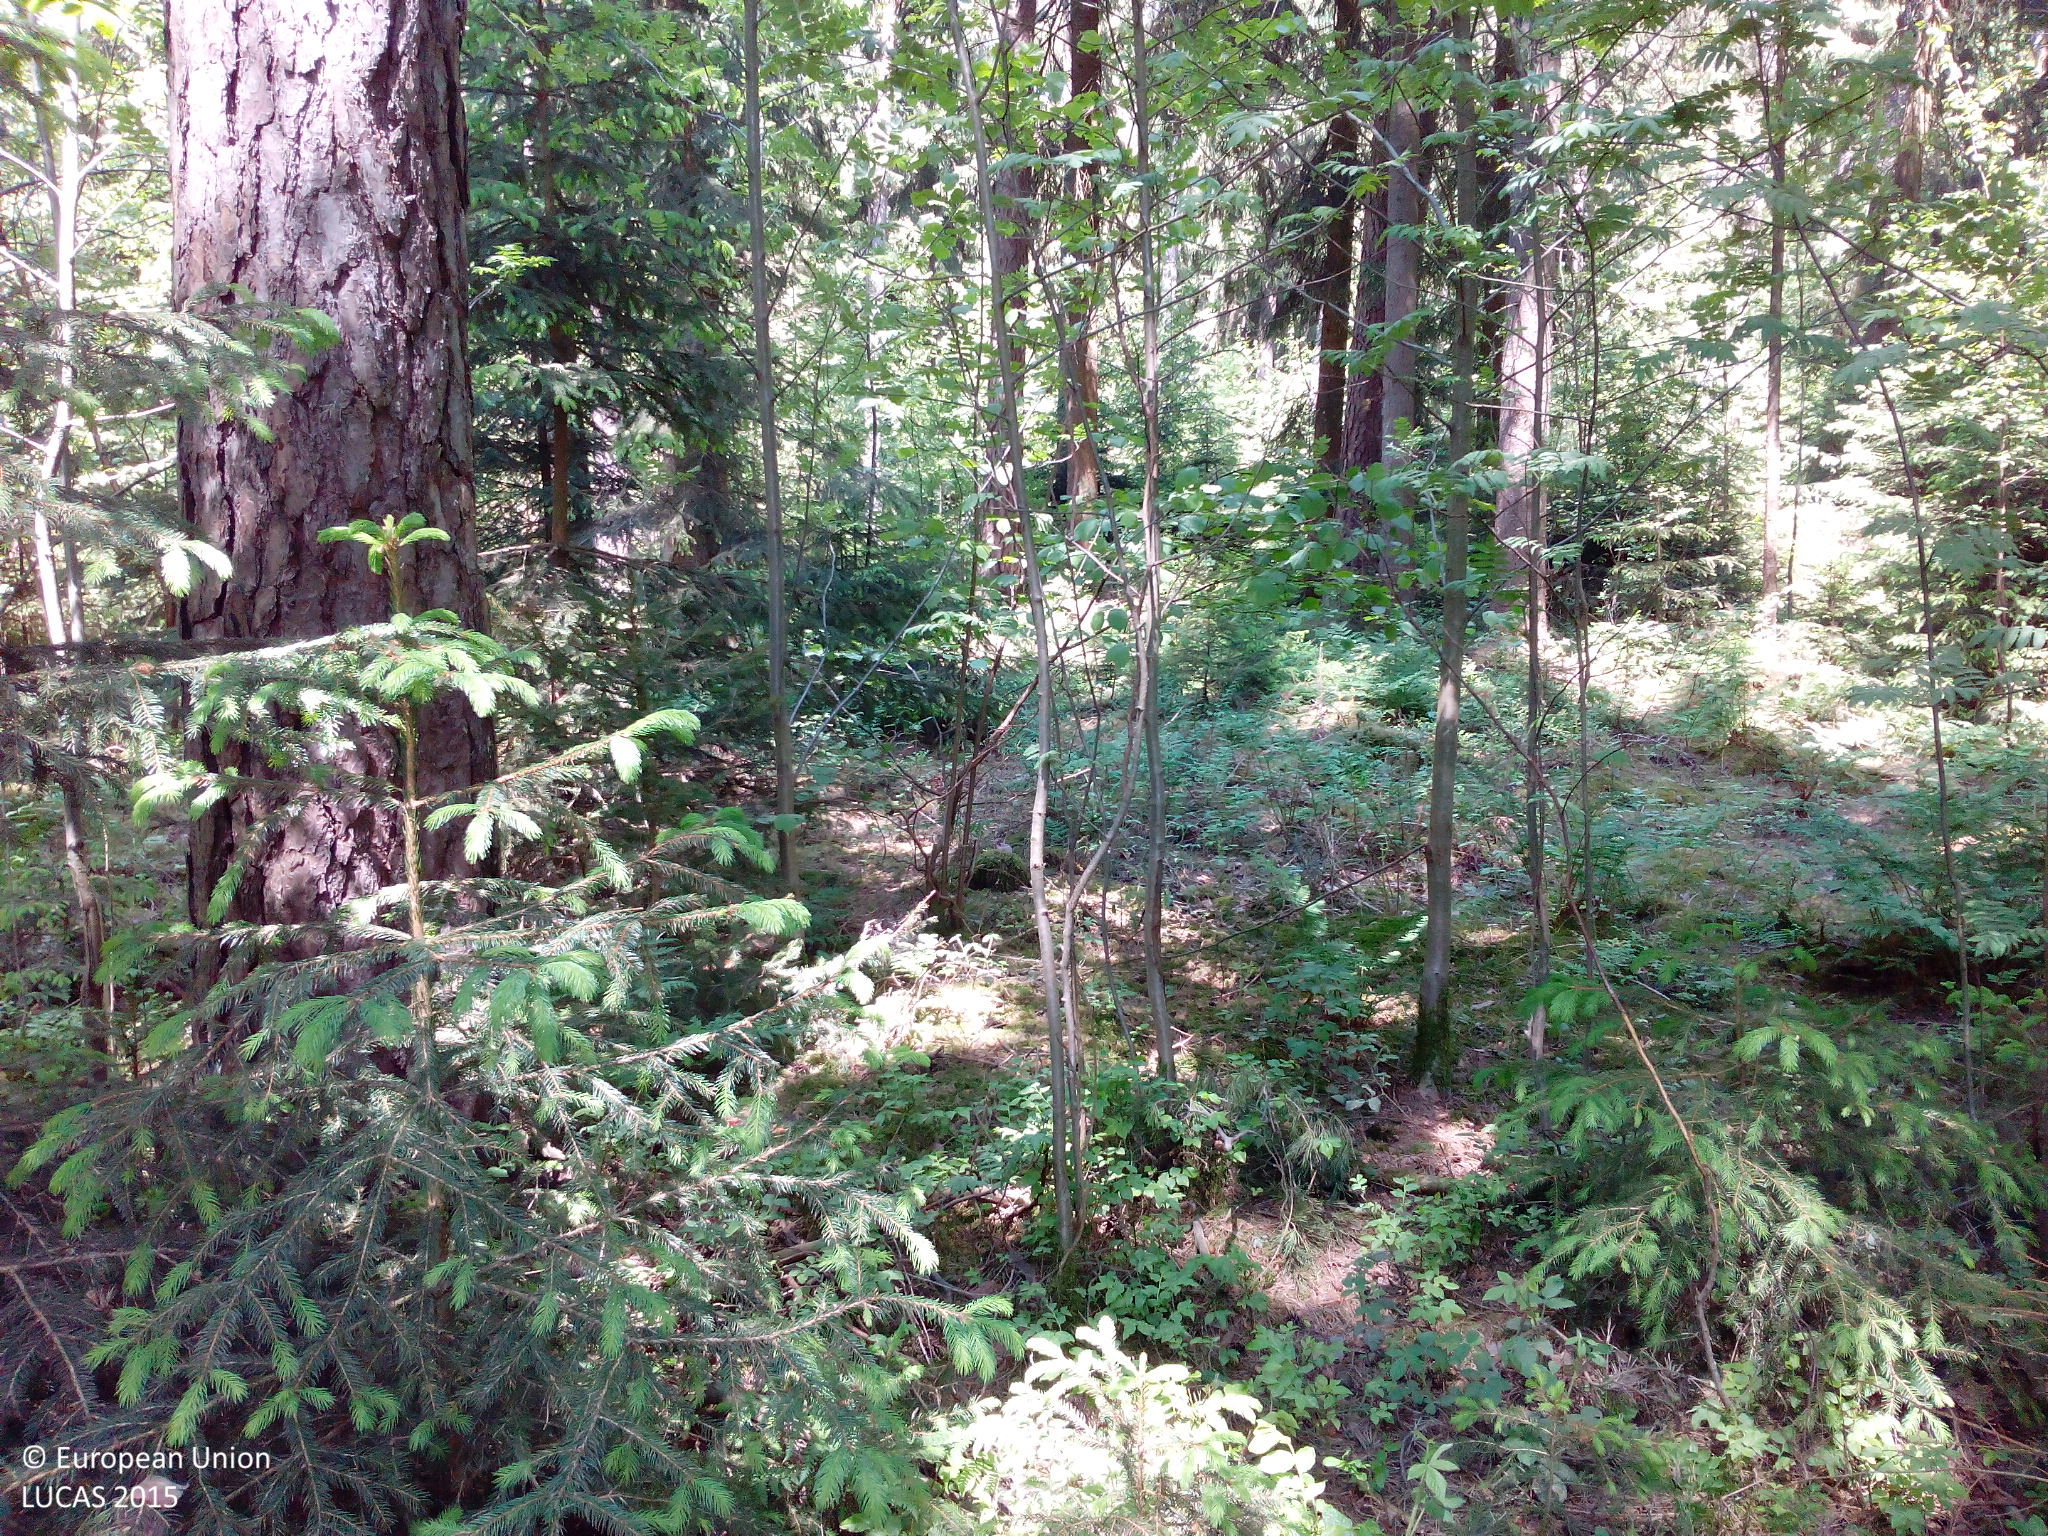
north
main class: Woodland
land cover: Other coniferous woodland
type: hemiboreal forest and nemoral coniferous forest and mixed broadleaved-coniferous forest
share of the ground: > 75 %
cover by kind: coniferous forest trees 75 %, herbaceous plants 10 %, lichens and mosses 10 %, broadleaved forest trees 5 %
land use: Forestry
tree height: > 5 m
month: May
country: DE
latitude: 49.1311
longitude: 11.4933
